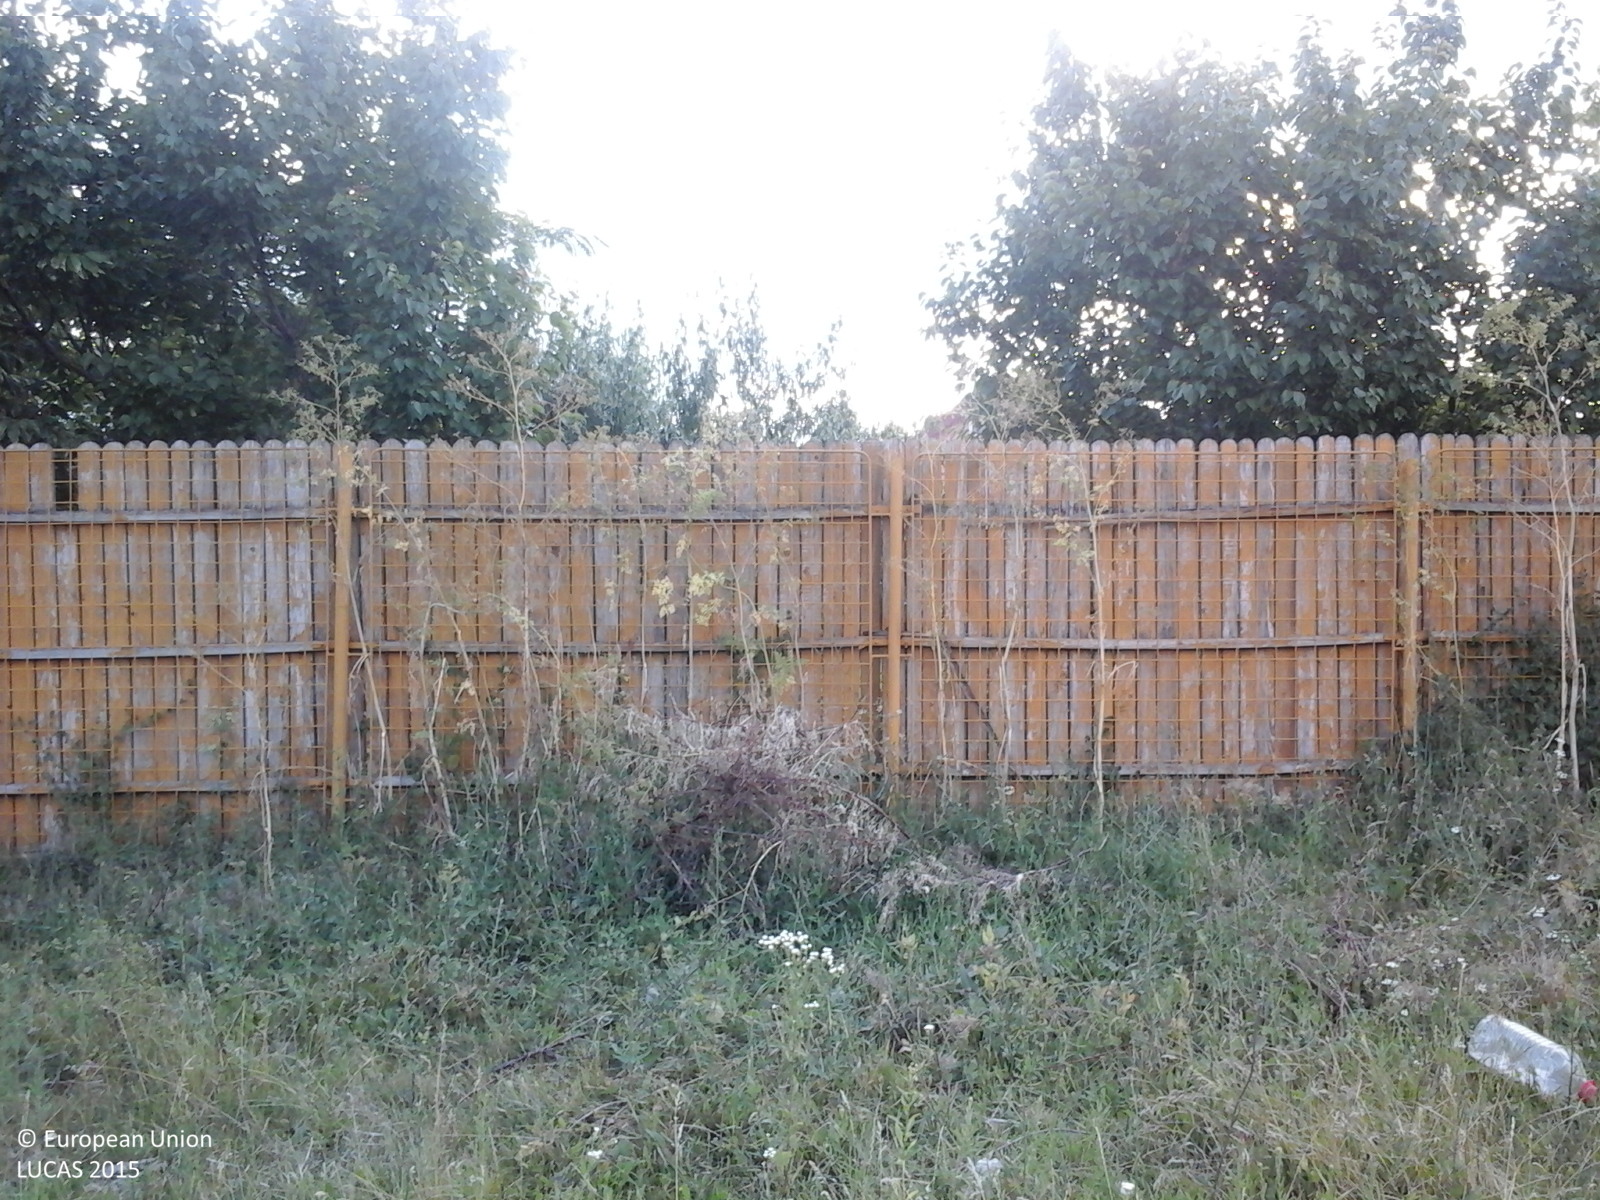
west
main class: Grassland
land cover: Grassland with sparse tree/shrub cover
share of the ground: > 75 %
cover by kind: herbaceous plants 95 %, broadleaved forest trees 5 %
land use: Agriculture (excluding fallow land and kitchen gardens)
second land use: Residential
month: June
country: RO
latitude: 44.5359
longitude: 26.2045
